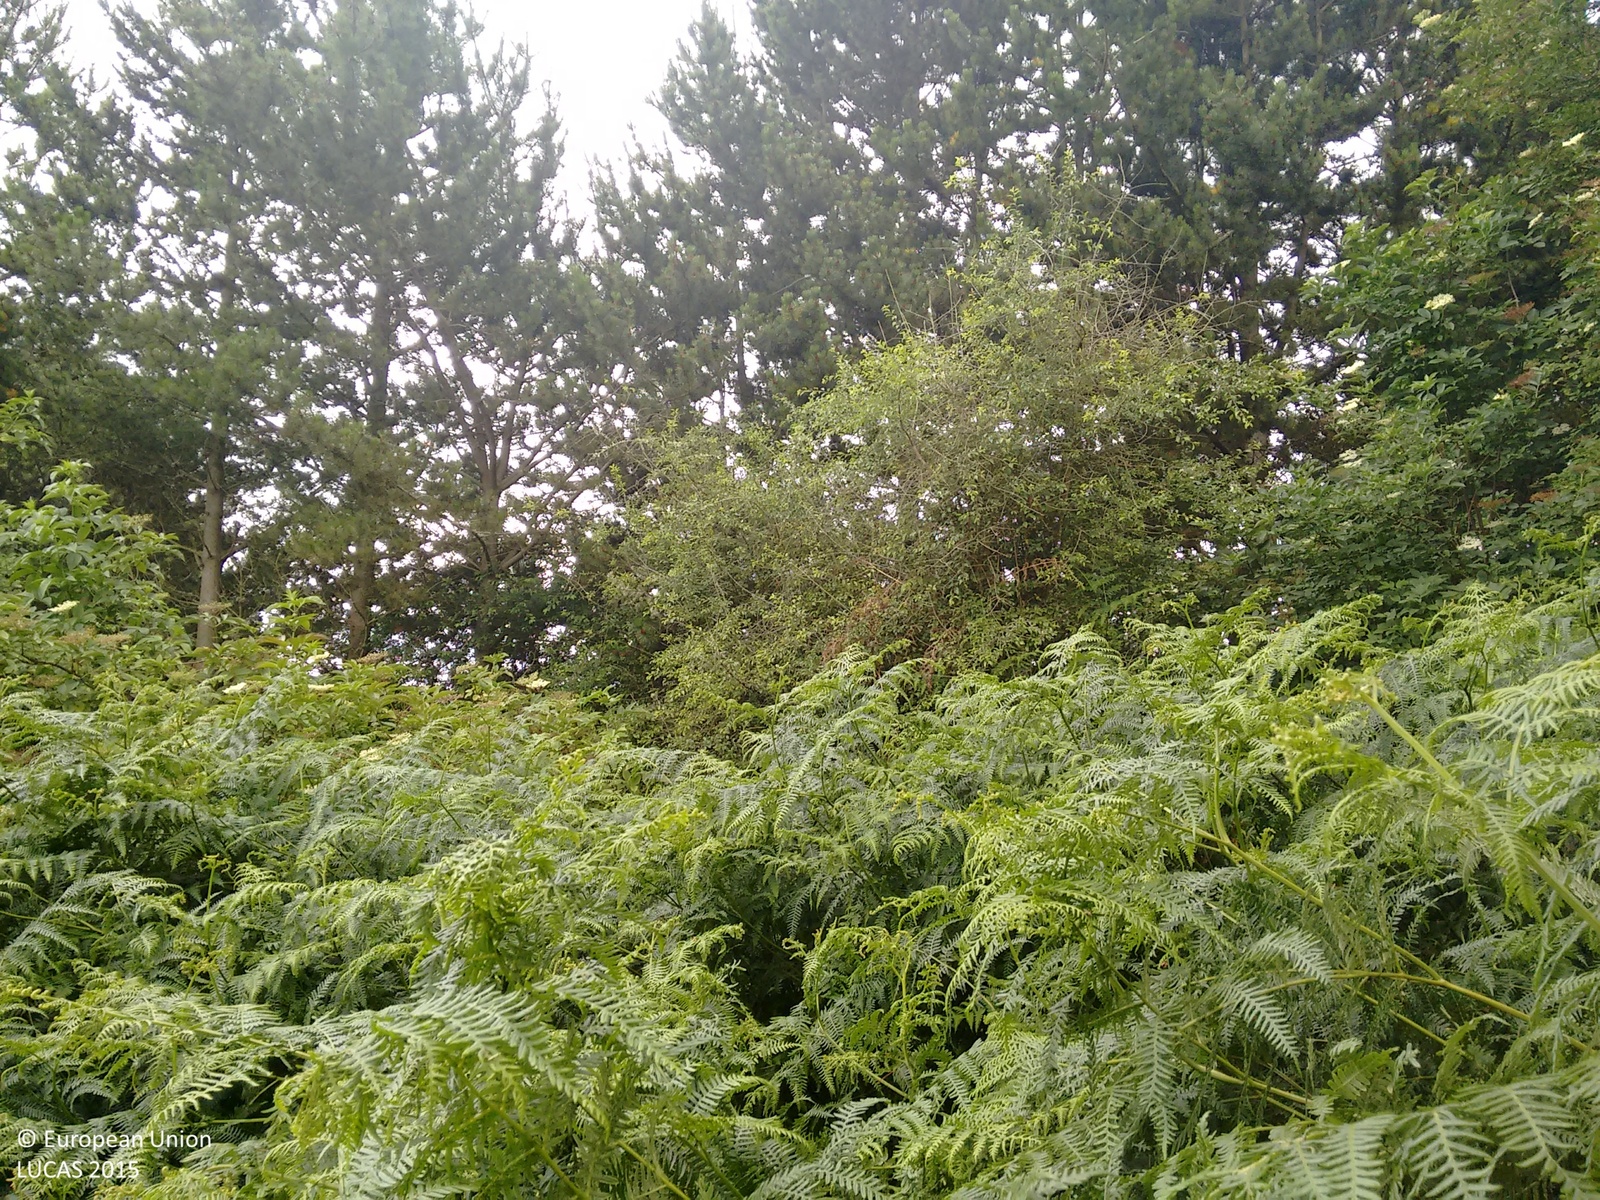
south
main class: Woodland
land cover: Other mixed woodland
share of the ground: > 75 %
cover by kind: coniferous forest trees 35 %, broadleaved forest trees 35 %, herbaceous plants 20 %, shrubs 10 %
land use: Residential
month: August
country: GB
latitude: 57.4701
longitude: -4.2755
